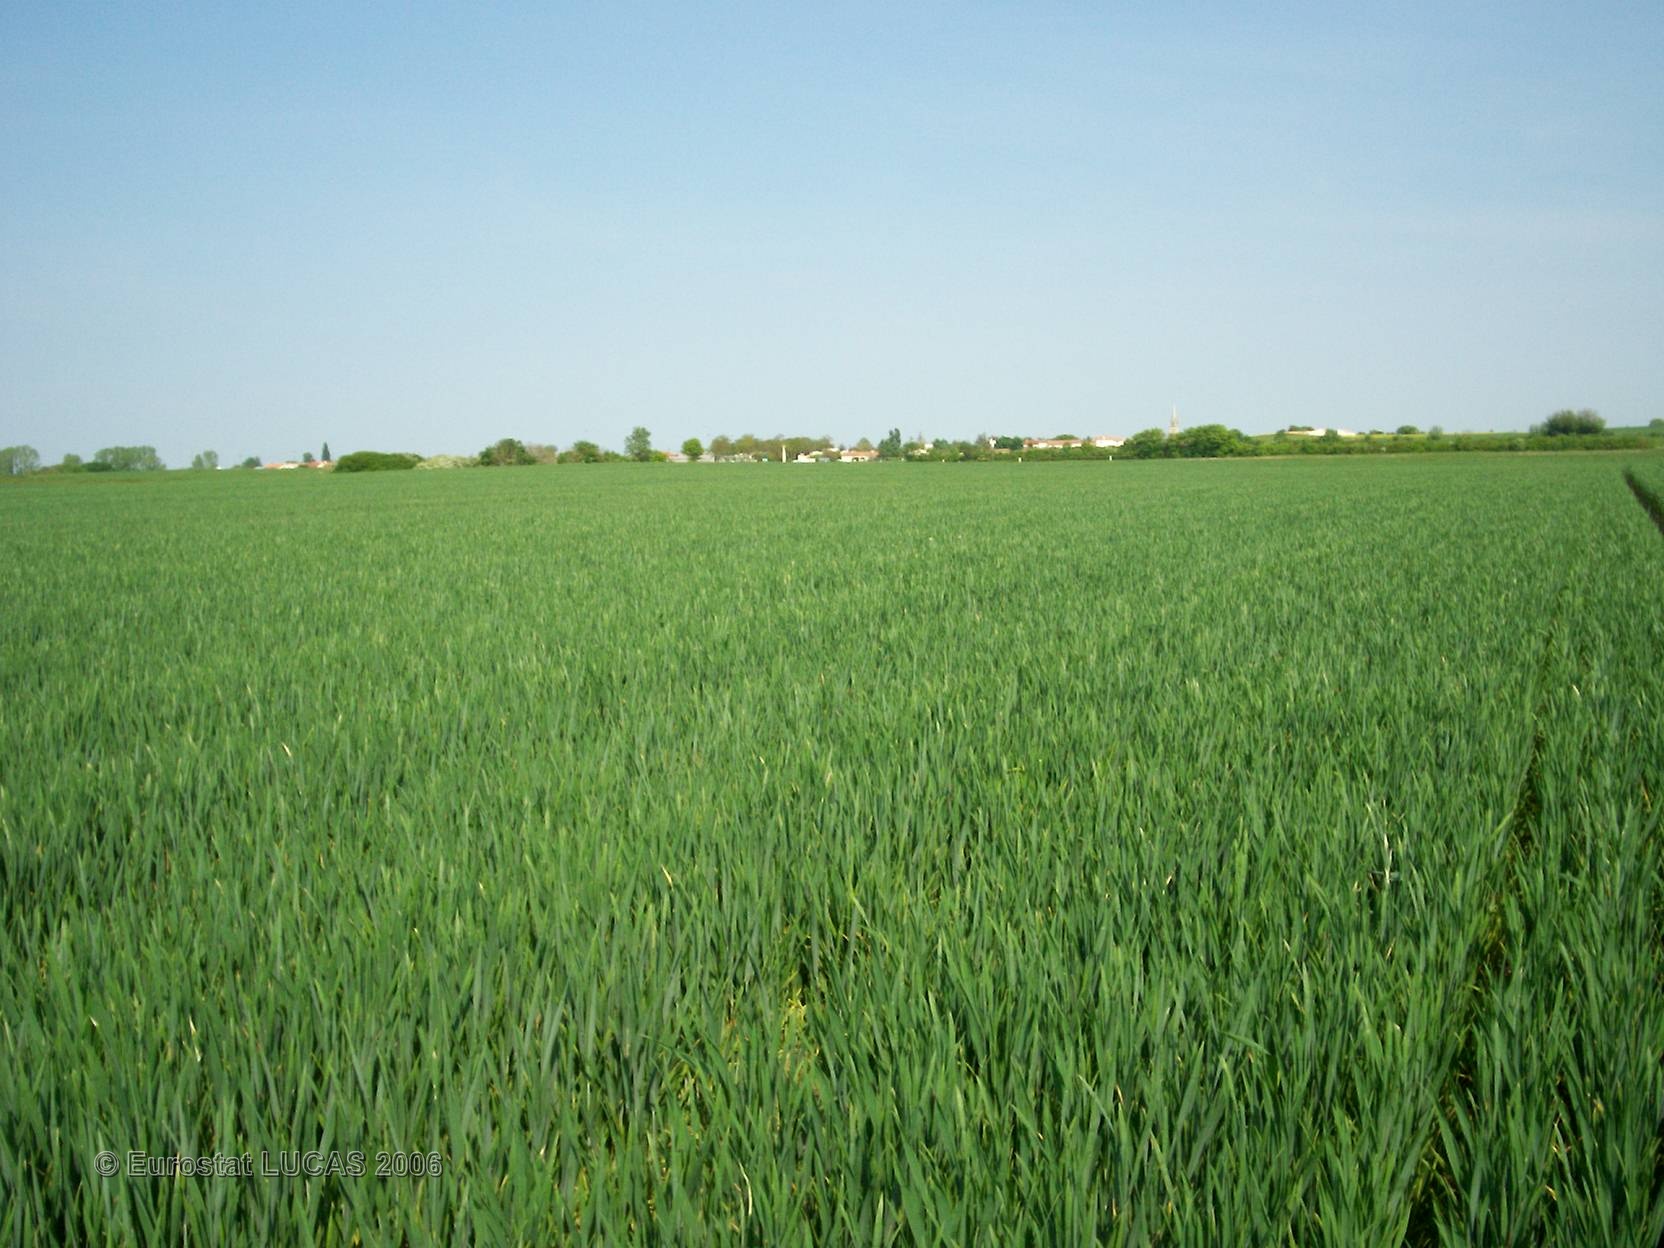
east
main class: Cropland
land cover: Common wheat
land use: Agriculture (excluding fallow land and kitchen gardens)
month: May
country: FR
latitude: 46.2638
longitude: -0.7315
